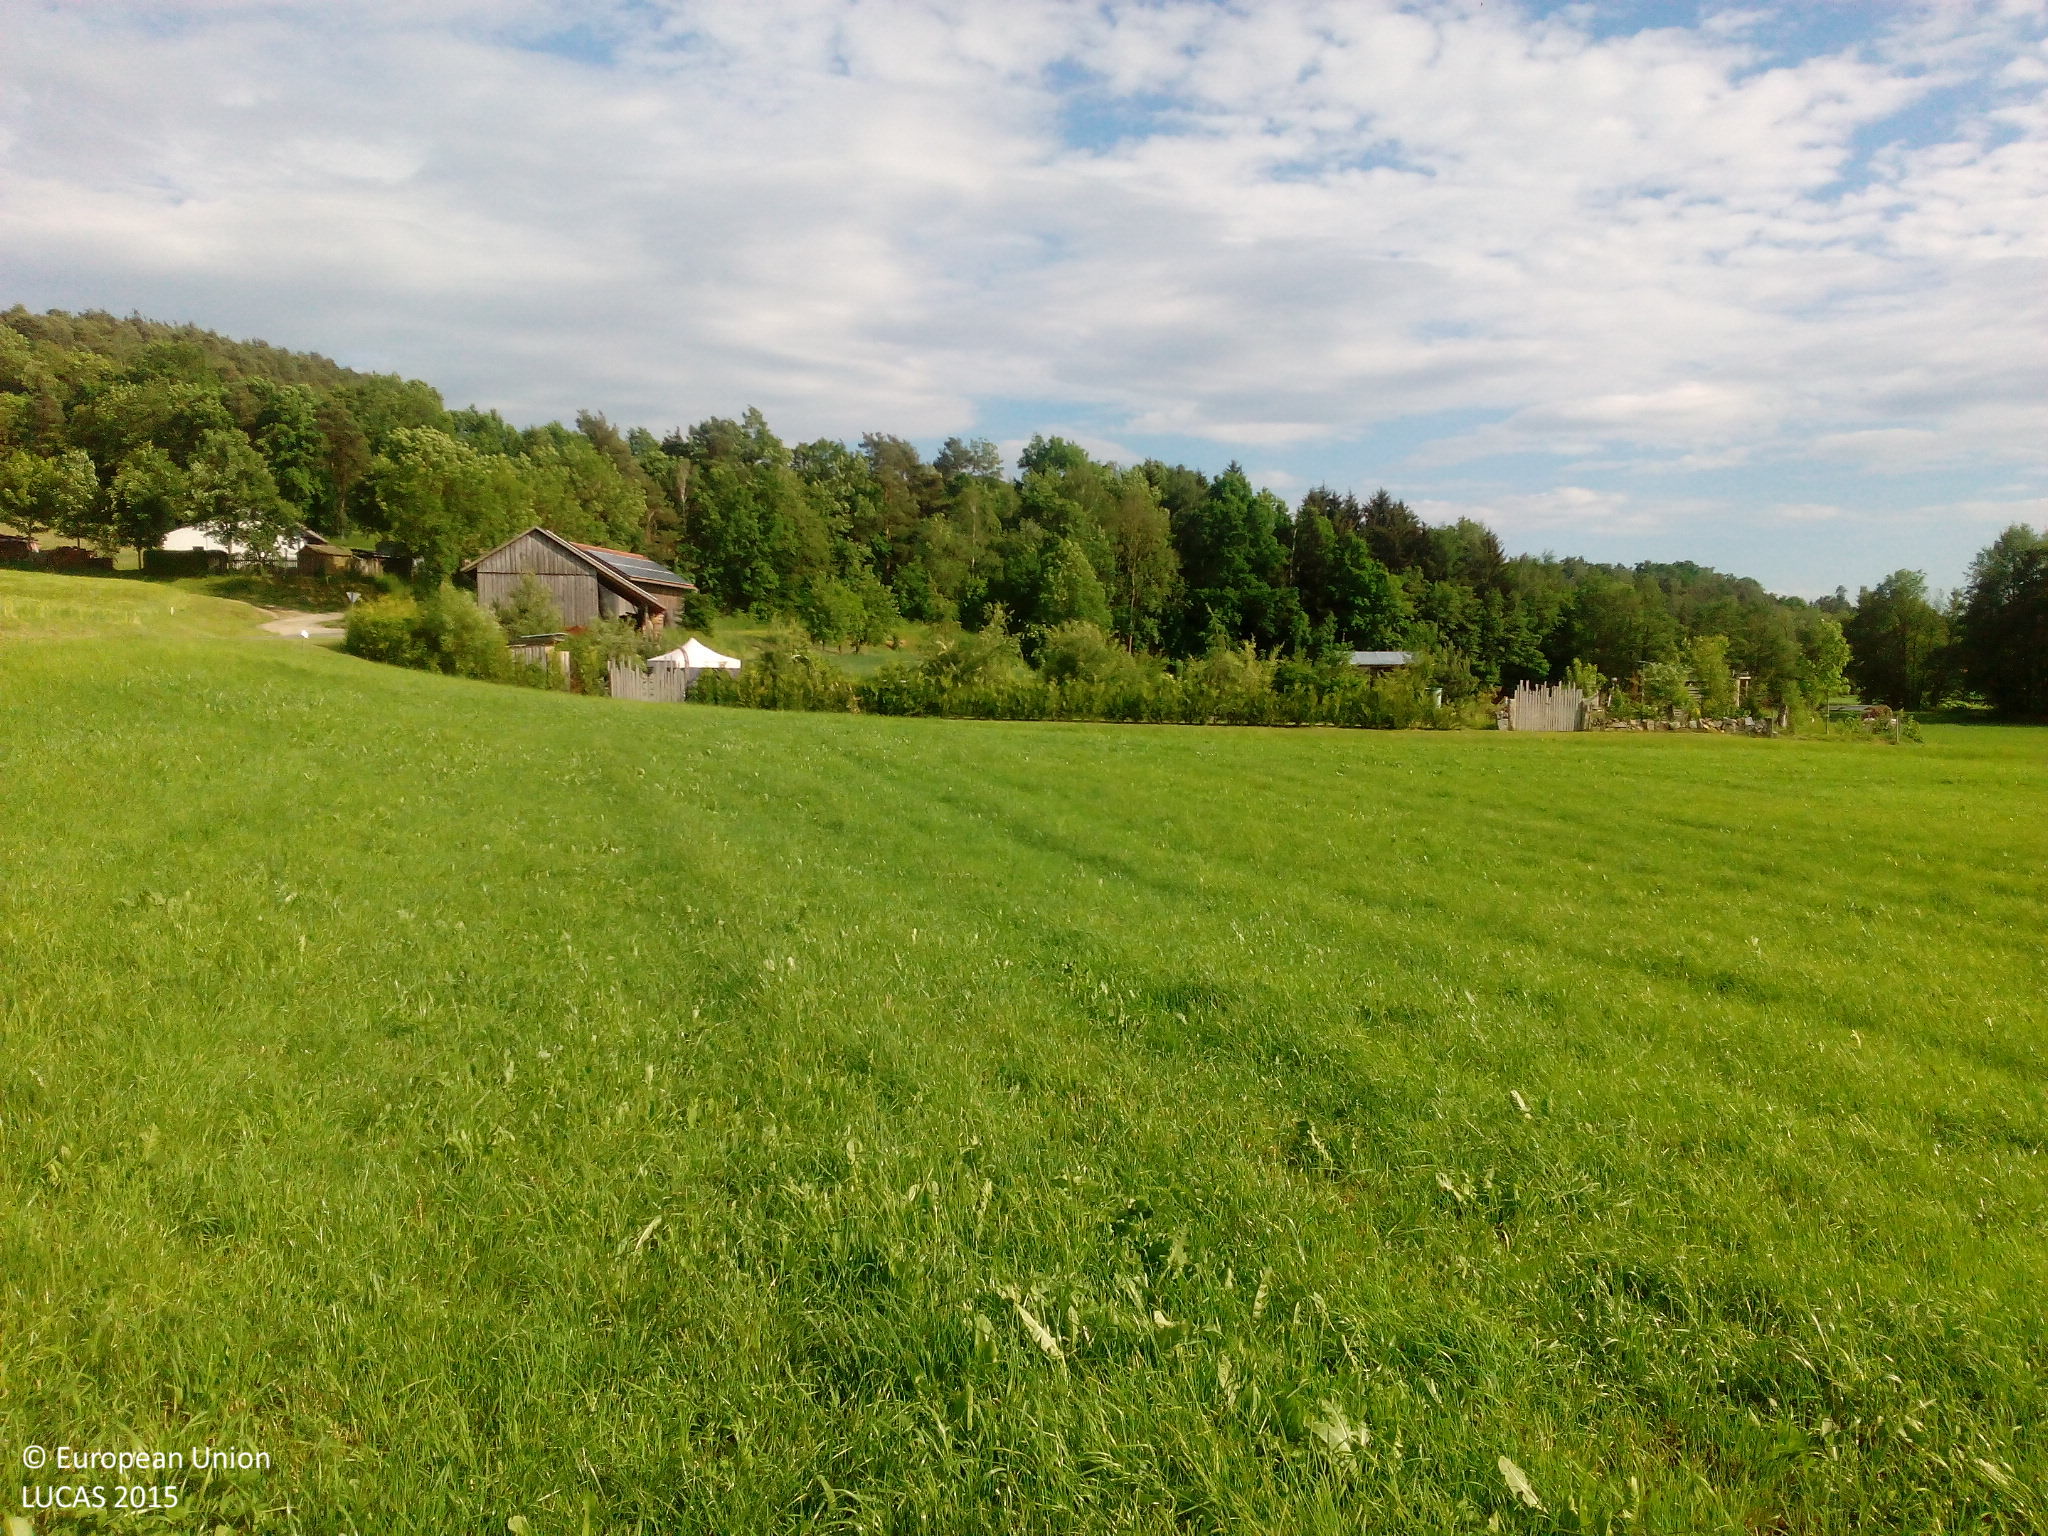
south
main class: Grassland
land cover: Grassland without tree/shrub cover
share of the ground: > 75 %
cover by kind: herbaceous plants 100 %
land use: Agriculture (excluding fallow land and kitchen gardens)
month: June
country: DE
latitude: 49.3677
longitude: 12.3819
